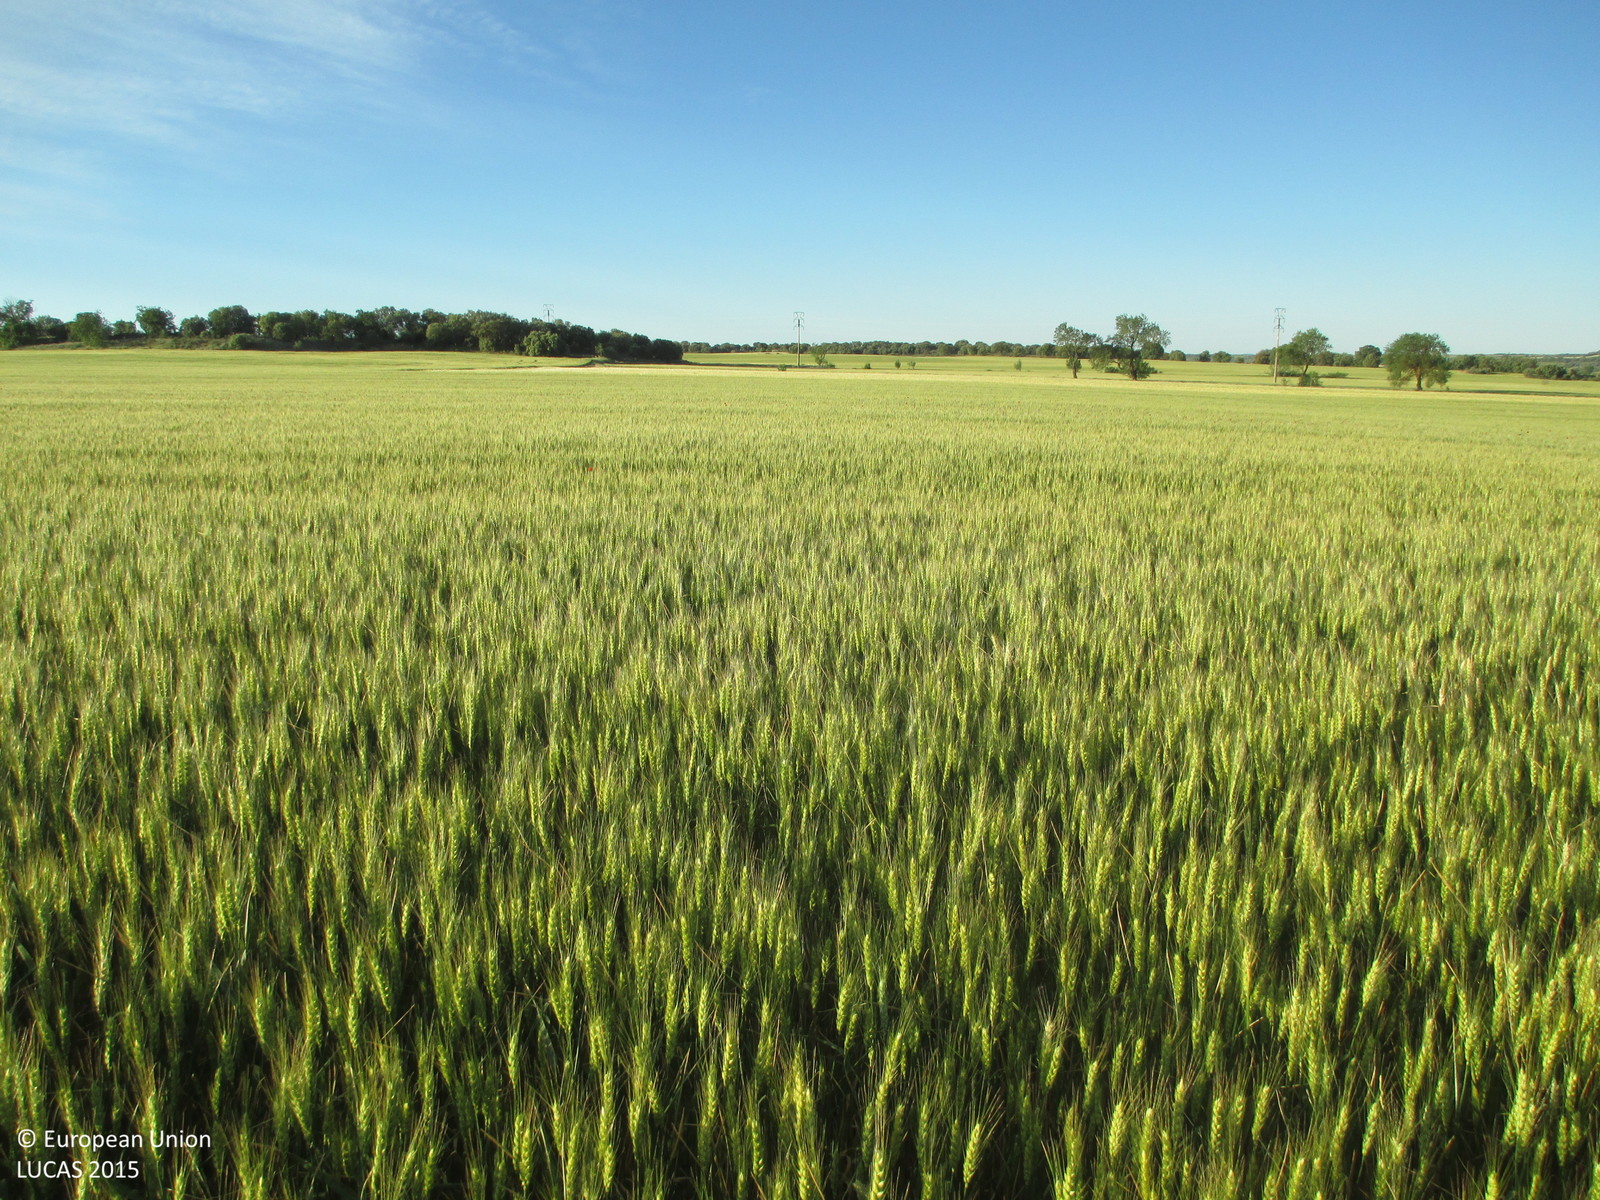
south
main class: Cropland
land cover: Durum wheat
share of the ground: > 75 %
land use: Agriculture (excluding fallow land and kitchen gardens)
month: May
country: ES
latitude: 42.1105
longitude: -0.2891
